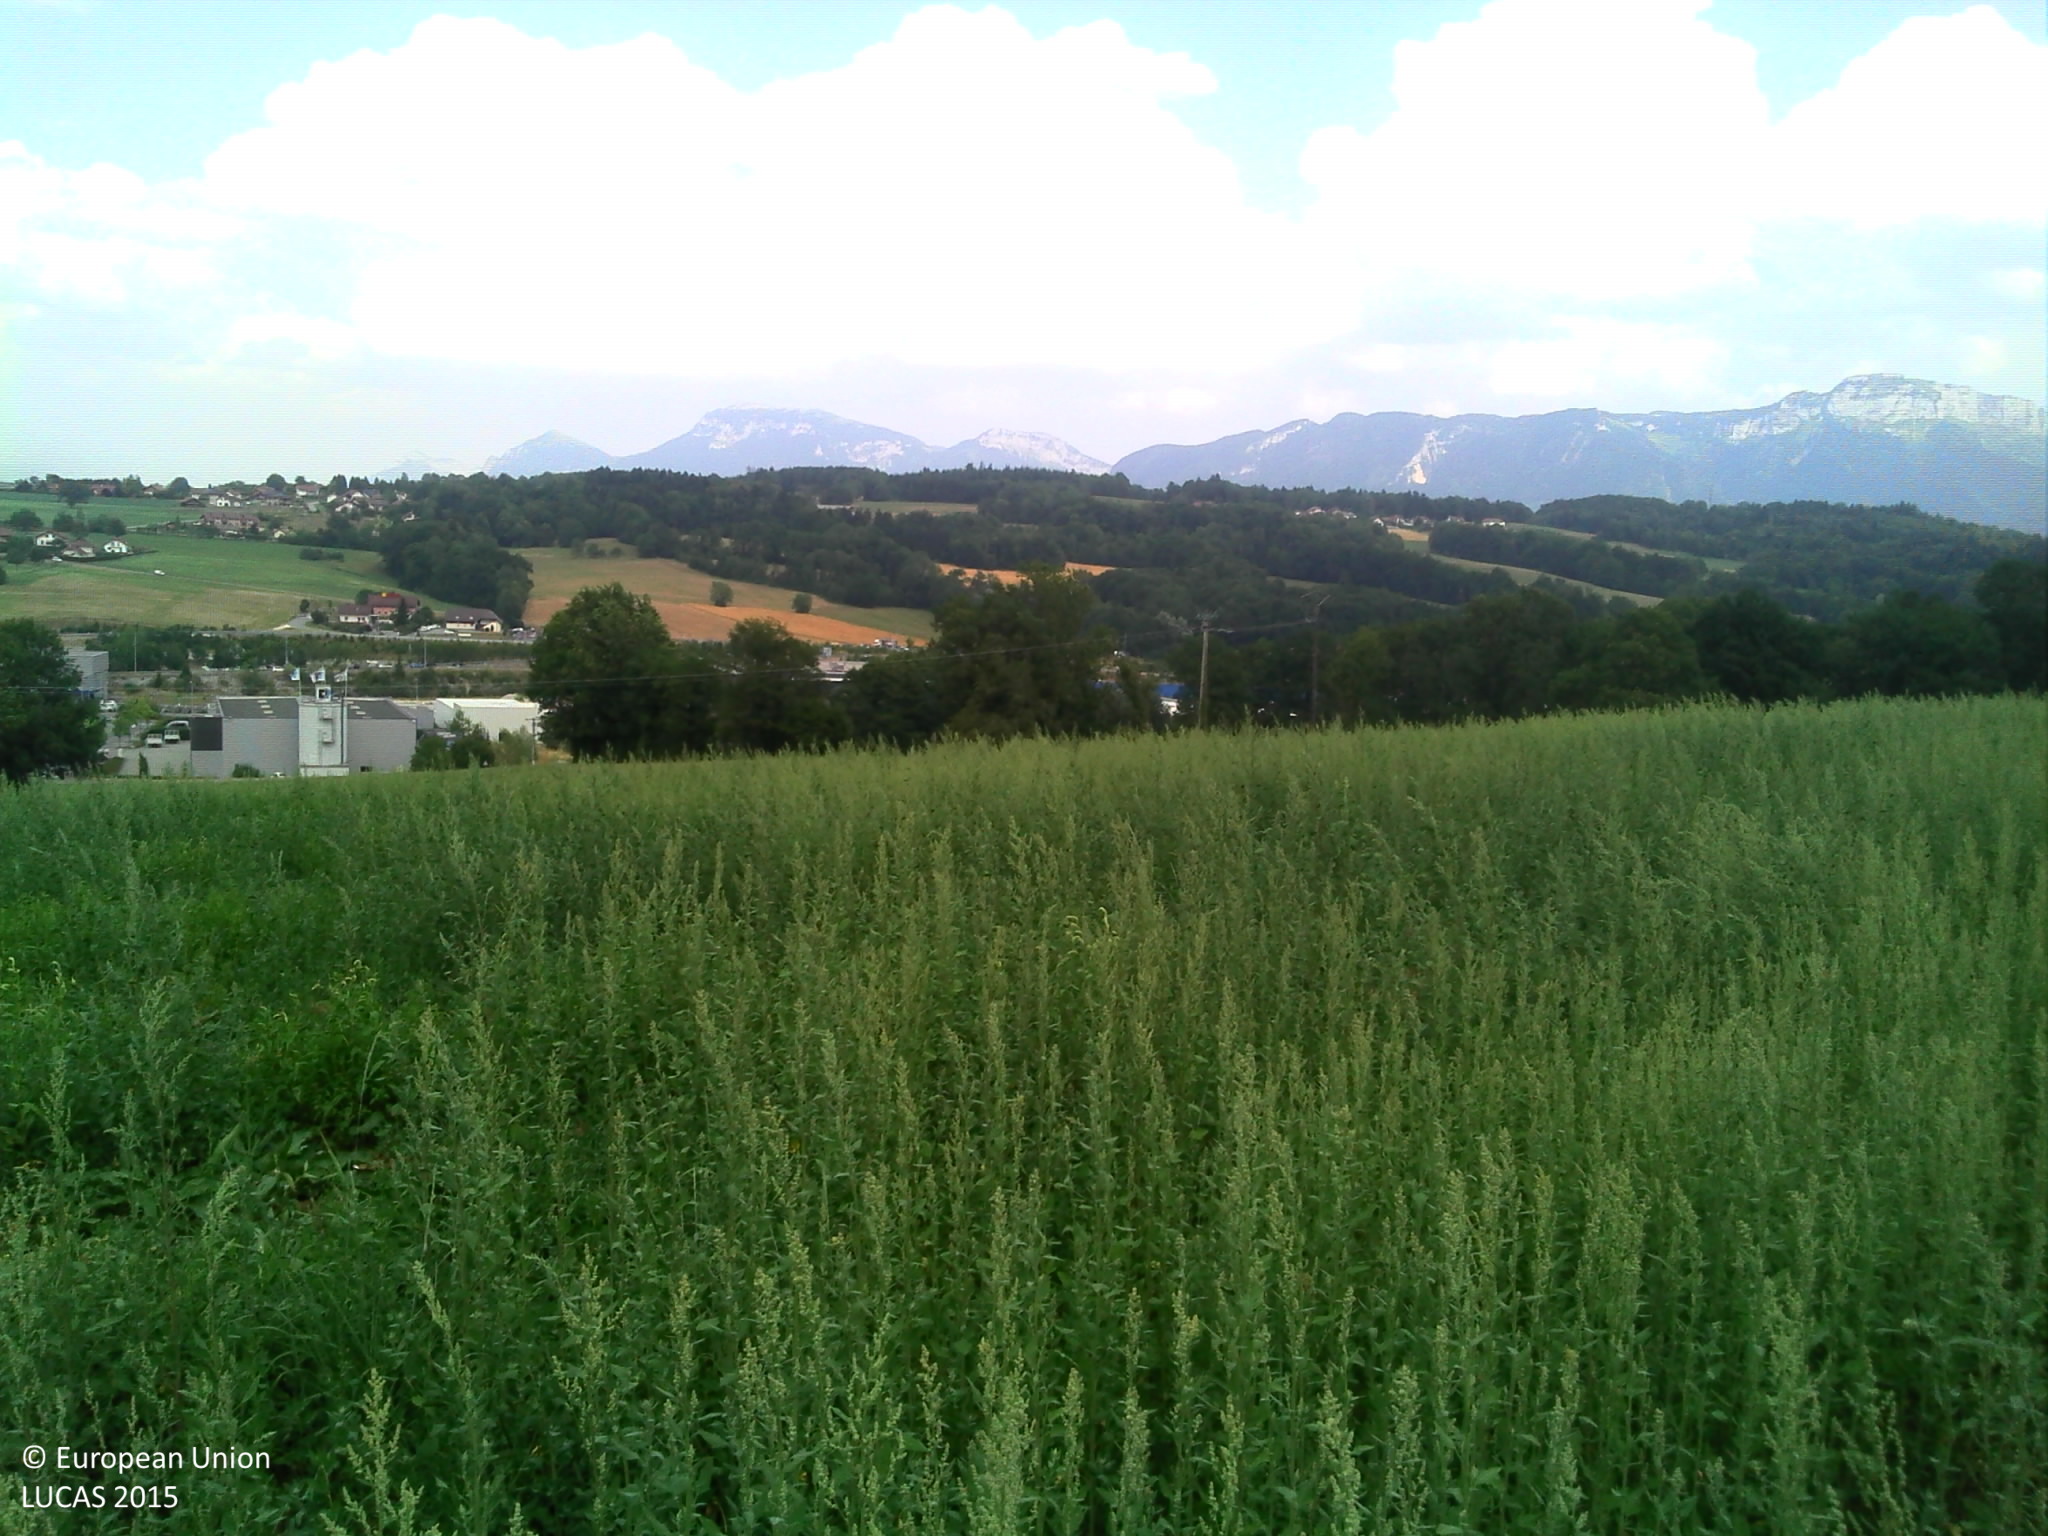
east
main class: Grassland
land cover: Spontaneously vegetated surfaces
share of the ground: > 75 %
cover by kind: herbaceous plants 100 %
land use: Agriculture (excluding fallow land and kitchen gardens)
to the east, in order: Spontaneously vegetated surfaces; Grassland without tree/shrub cover; Fences; Electric lines; Grassland without tree/shrub cover; Ditches and canals; Paved roads, cycling and walking lanes; Grassland without tree/shrub cover; Broadleaved woodland; Grassland without tree/shrub cover; Electric lines; Grassland without tree/shrub cover
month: July
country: FR
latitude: 45.9922
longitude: 6.1177
